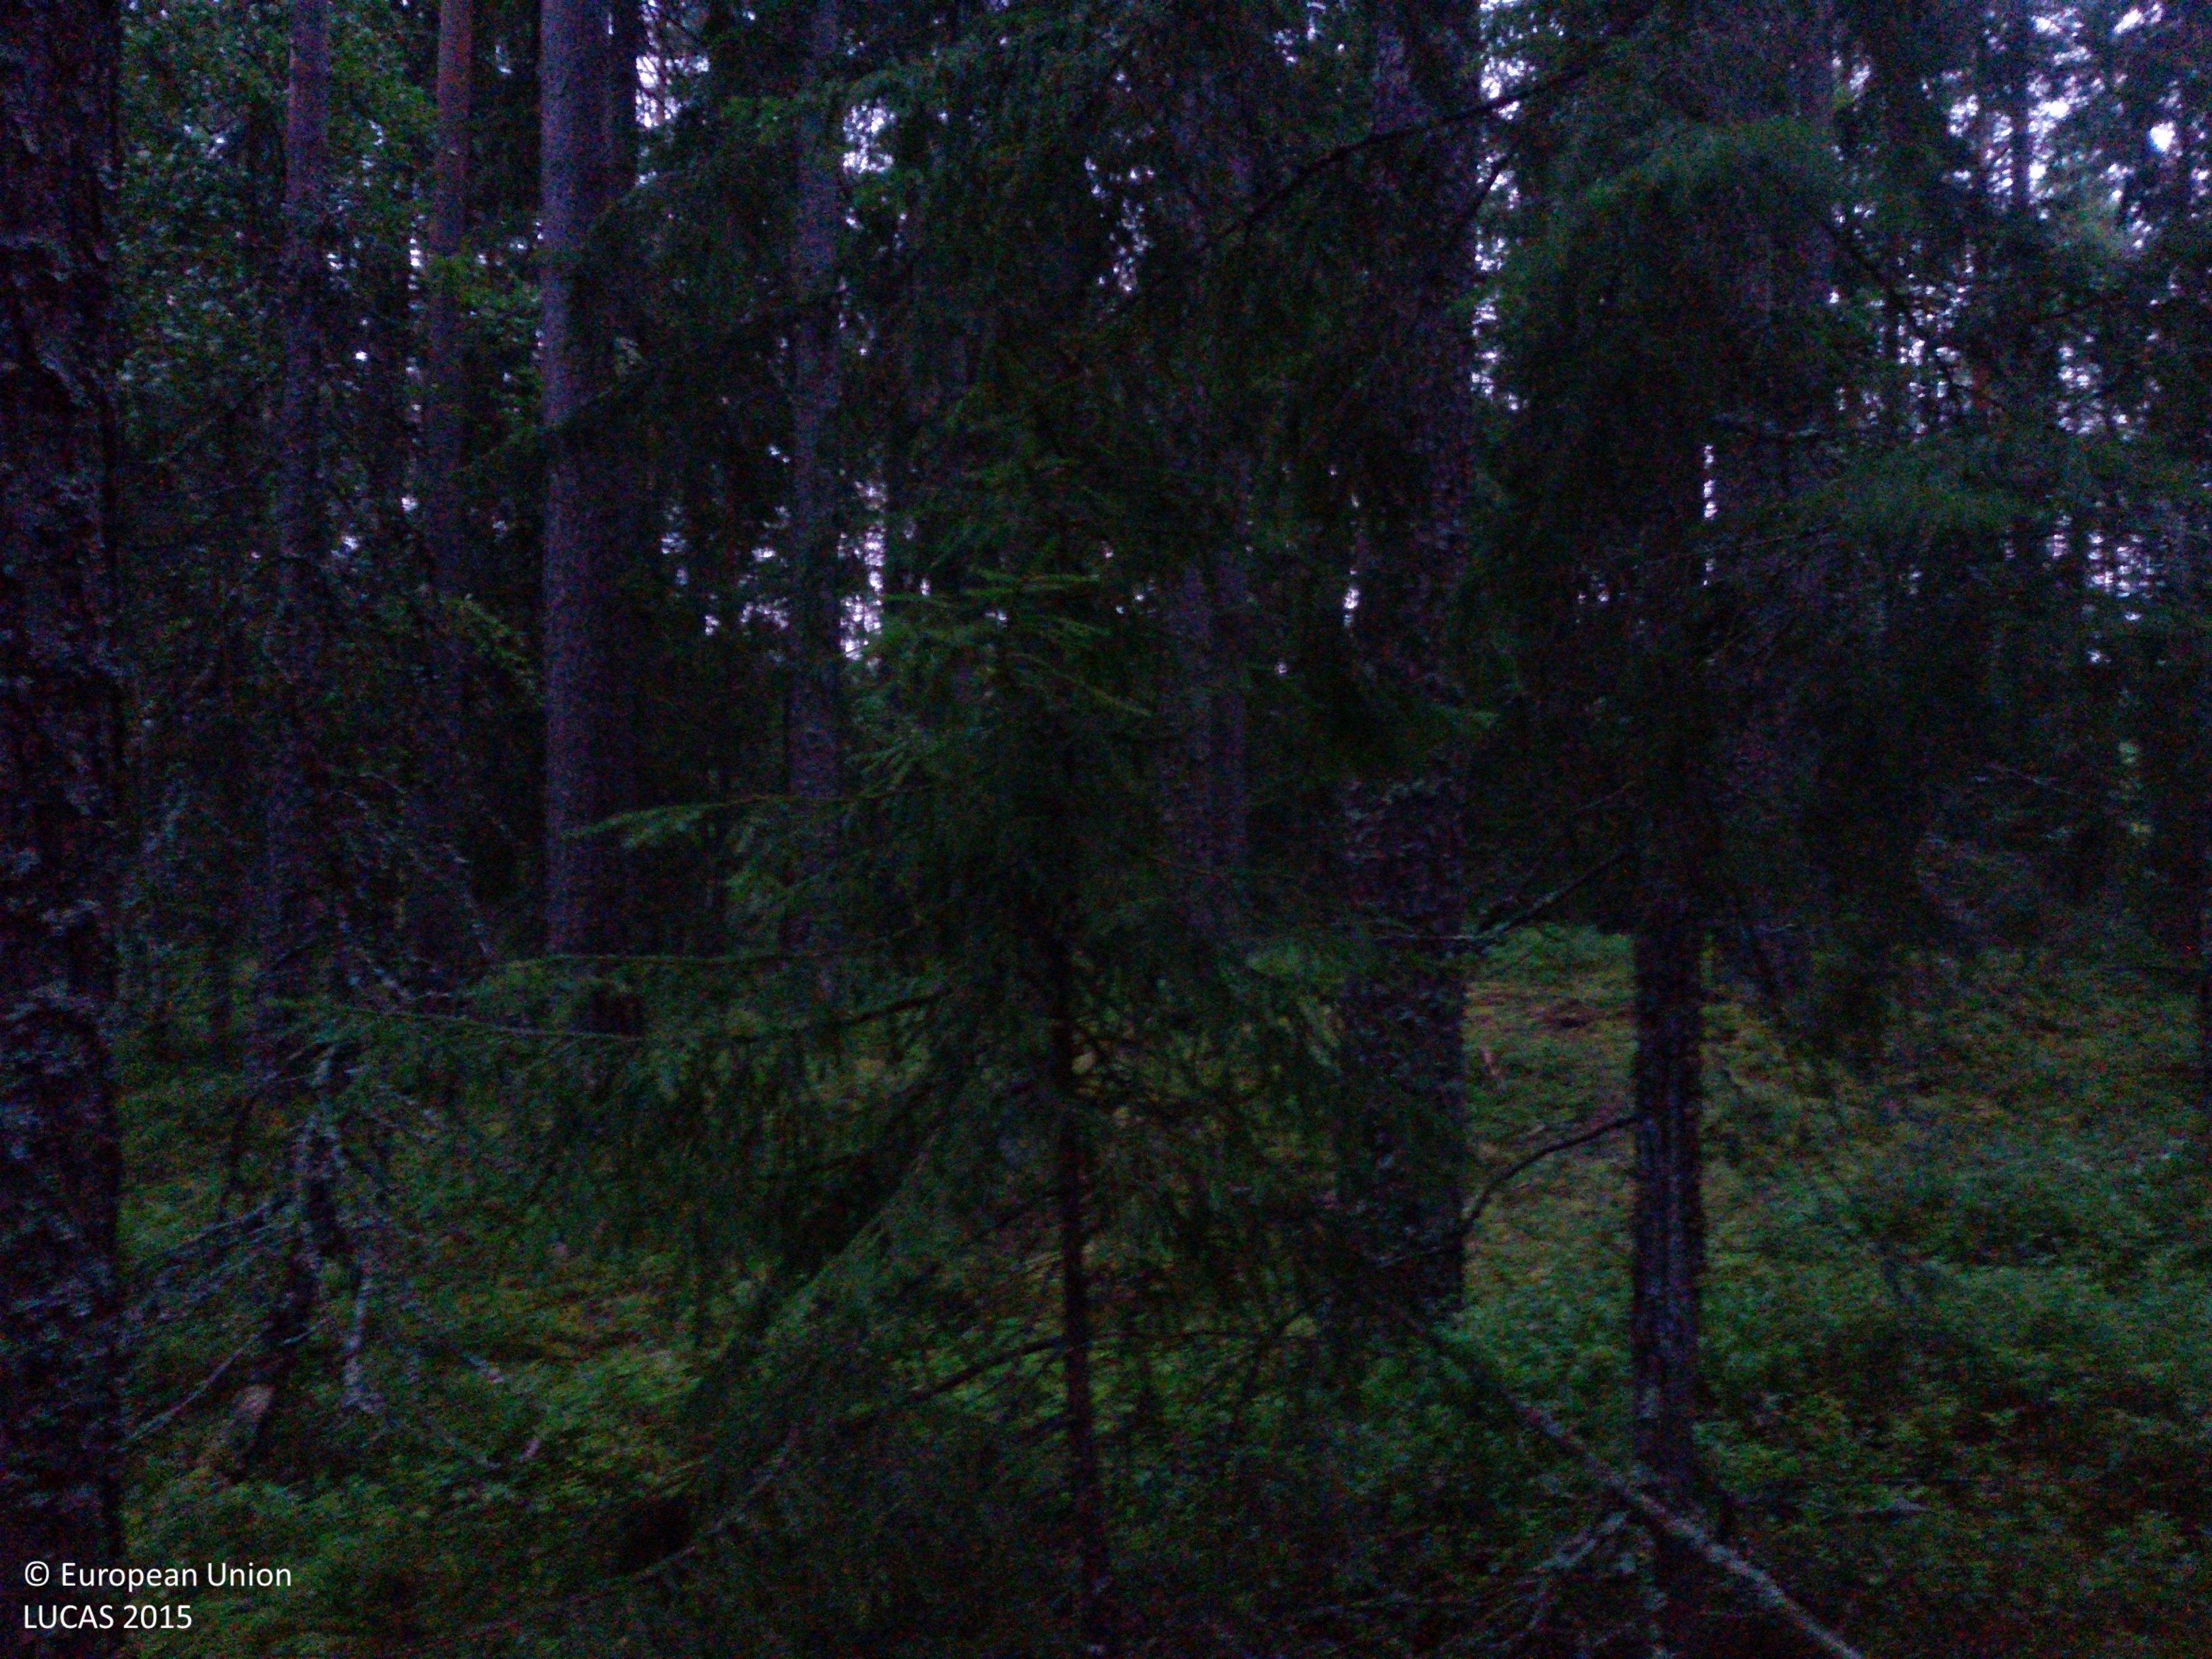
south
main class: Woodland
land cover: Pine dominated coniferous woodland
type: boreal forest
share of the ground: > 75 %
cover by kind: coniferous forest trees 90 %, shrubs 10 %
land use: Forestry
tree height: > 5 m
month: July
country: SE
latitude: 60.5653
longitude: 15.8433
